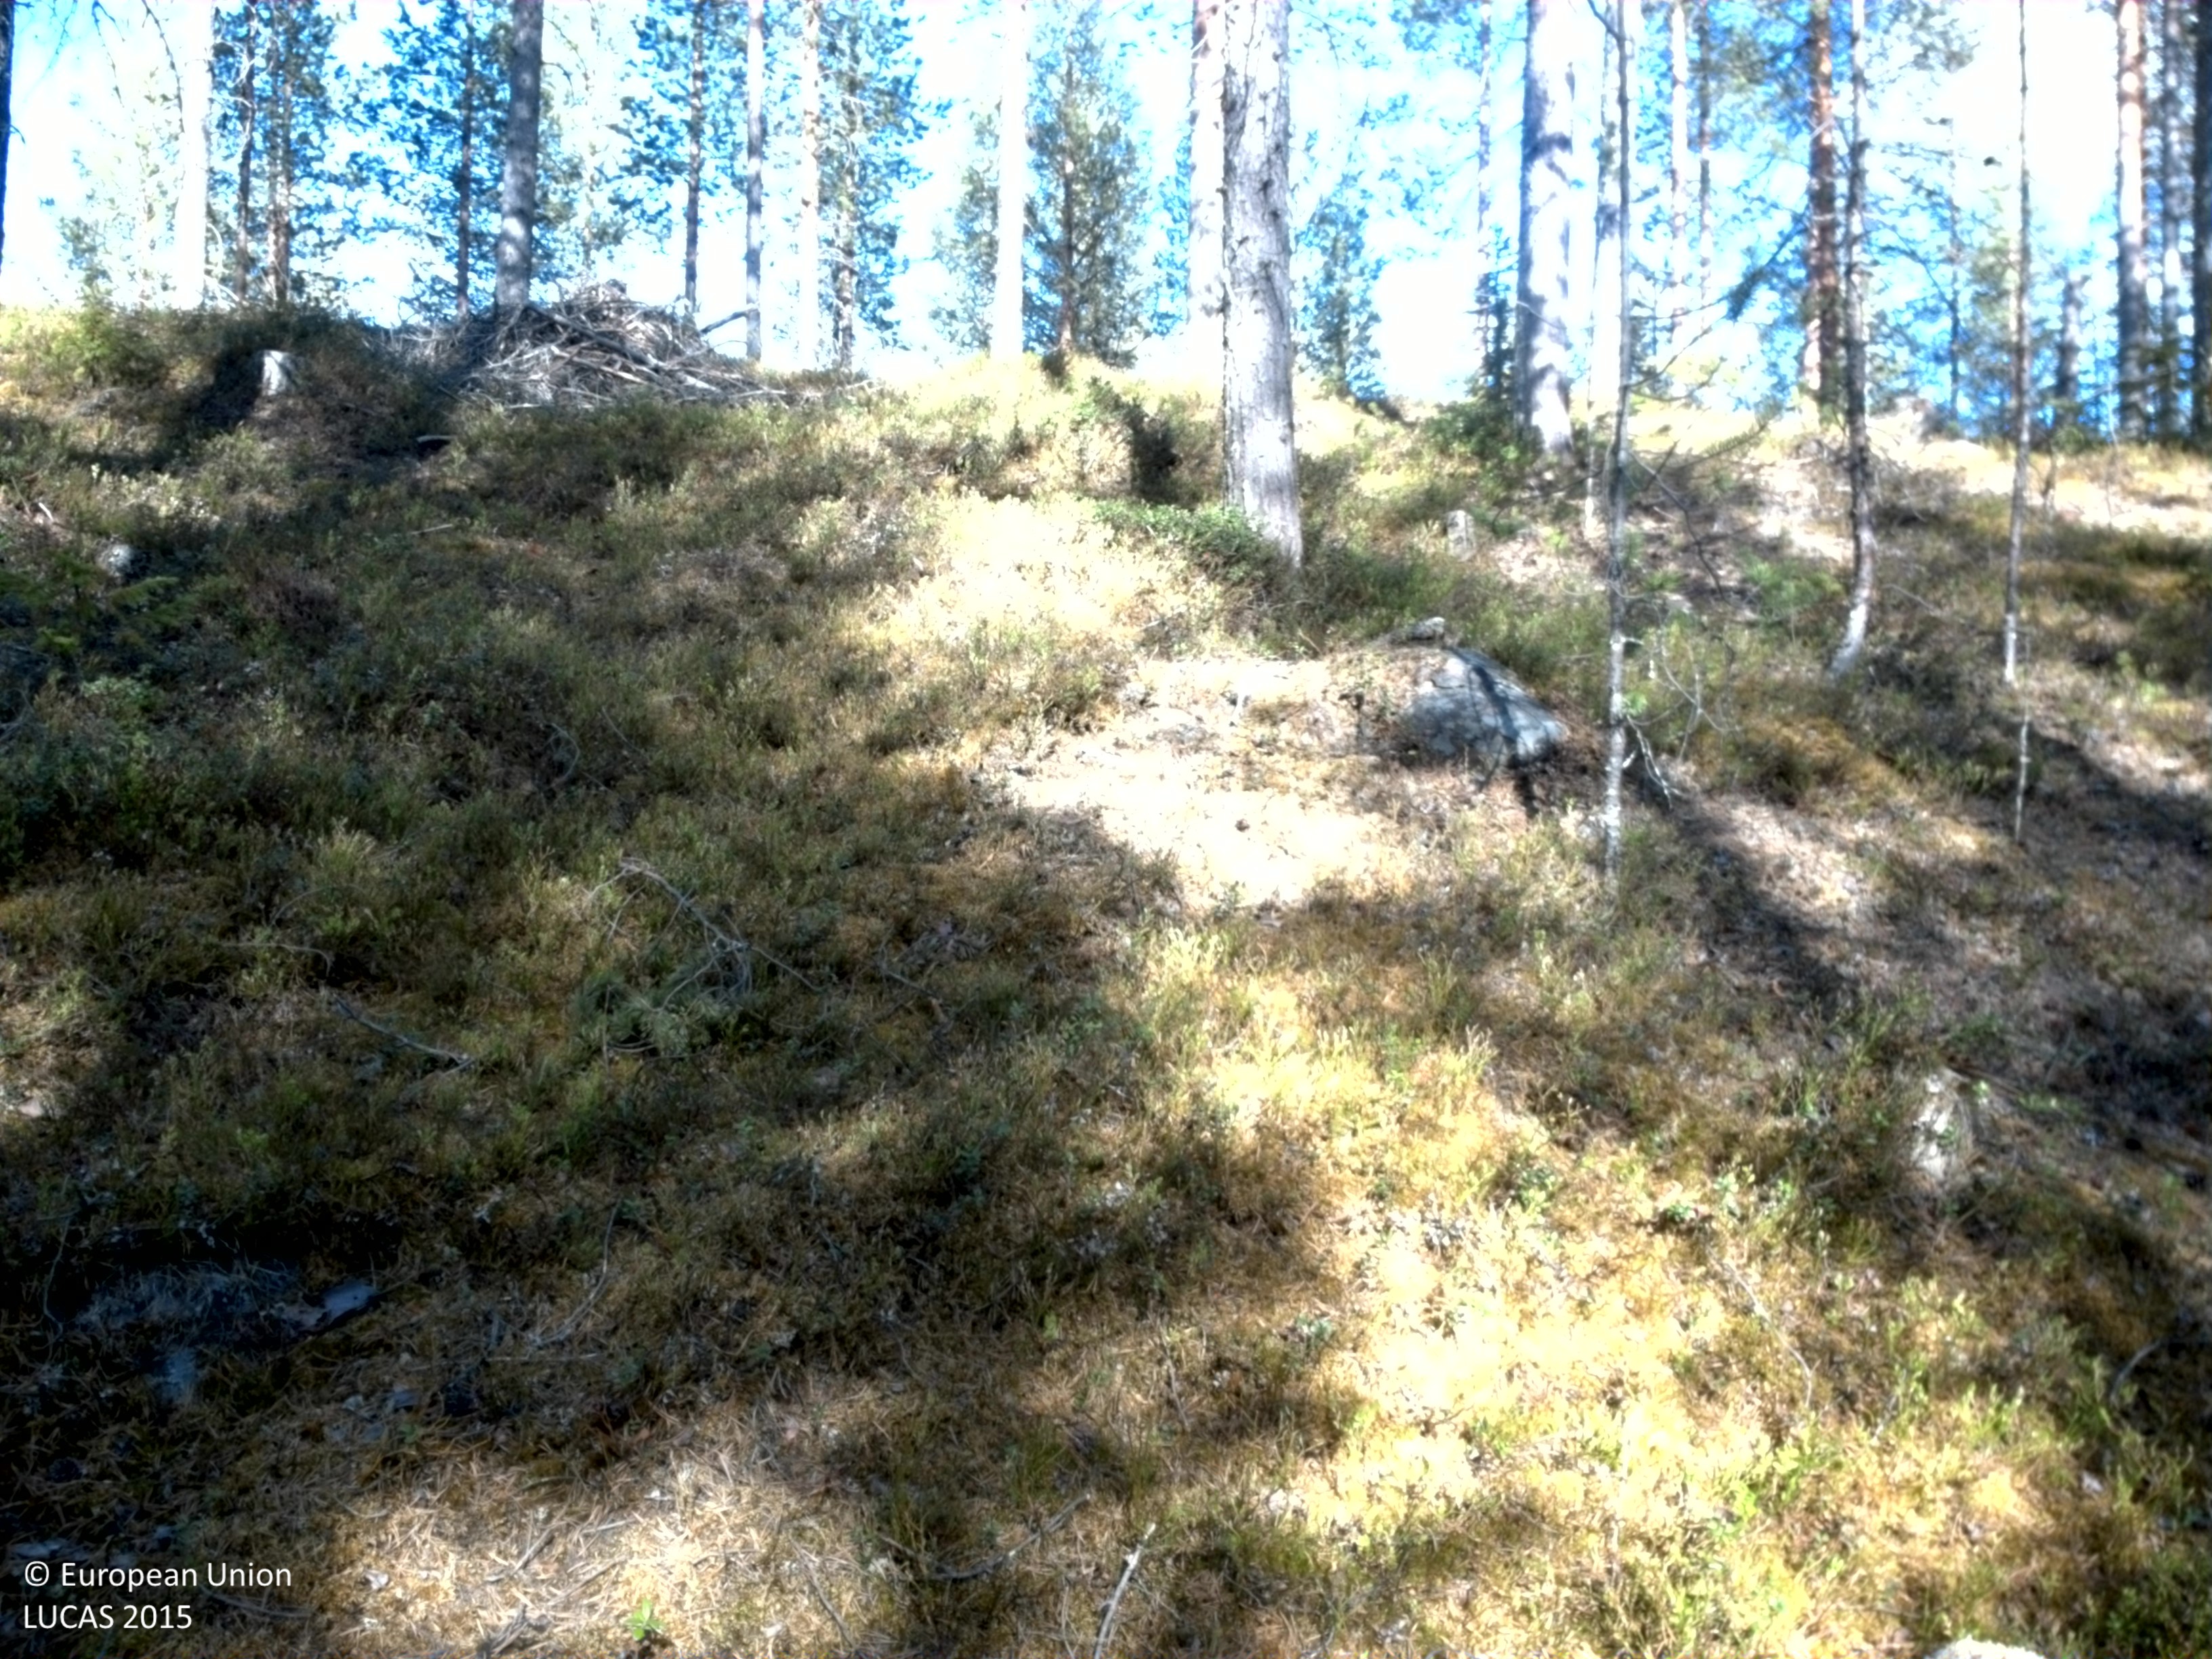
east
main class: Woodland
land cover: Pine dominated coniferous woodland
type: boreal forest
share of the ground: 25 - 50 %
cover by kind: herbaceous plants 65 %, coniferous forest trees 35 %
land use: Forestry
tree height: > 5 m
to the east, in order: Pine dominated coniferous woodland
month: June
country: SE
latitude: 66.9420
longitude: 21.2811
